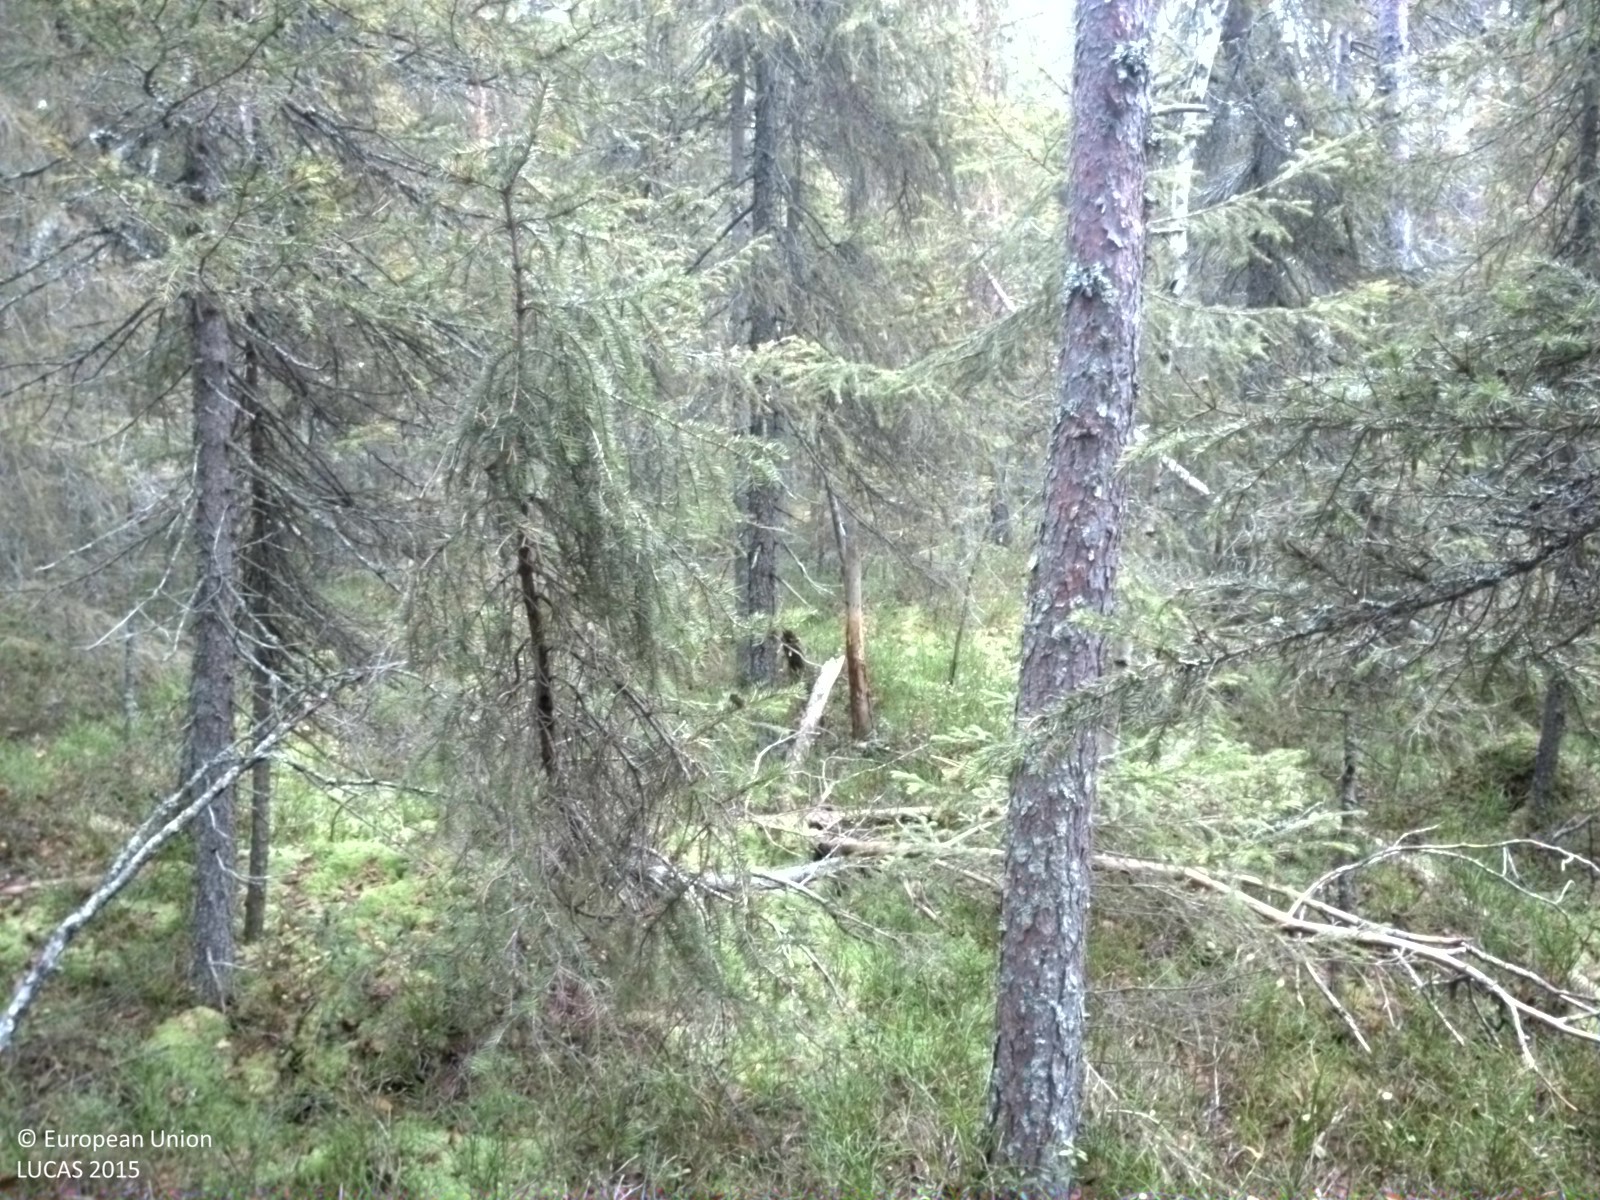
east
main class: Woodland
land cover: Other coniferous woodland
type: boreal forest
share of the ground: 50 - 75 %
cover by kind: coniferous forest trees 45 %, shrubs 45 %, broadleaved forest trees 5 %, lichens and mosses 5 %
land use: Forestry
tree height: > 5 m
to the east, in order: Other coniferous woodland; Pine dominated coniferous woodland; Broadleaved woodland; Rivers and streams; Broadleaved woodland; Pine dominated coniferous woodland
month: October
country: SE
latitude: 66.0201
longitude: 22.3913
